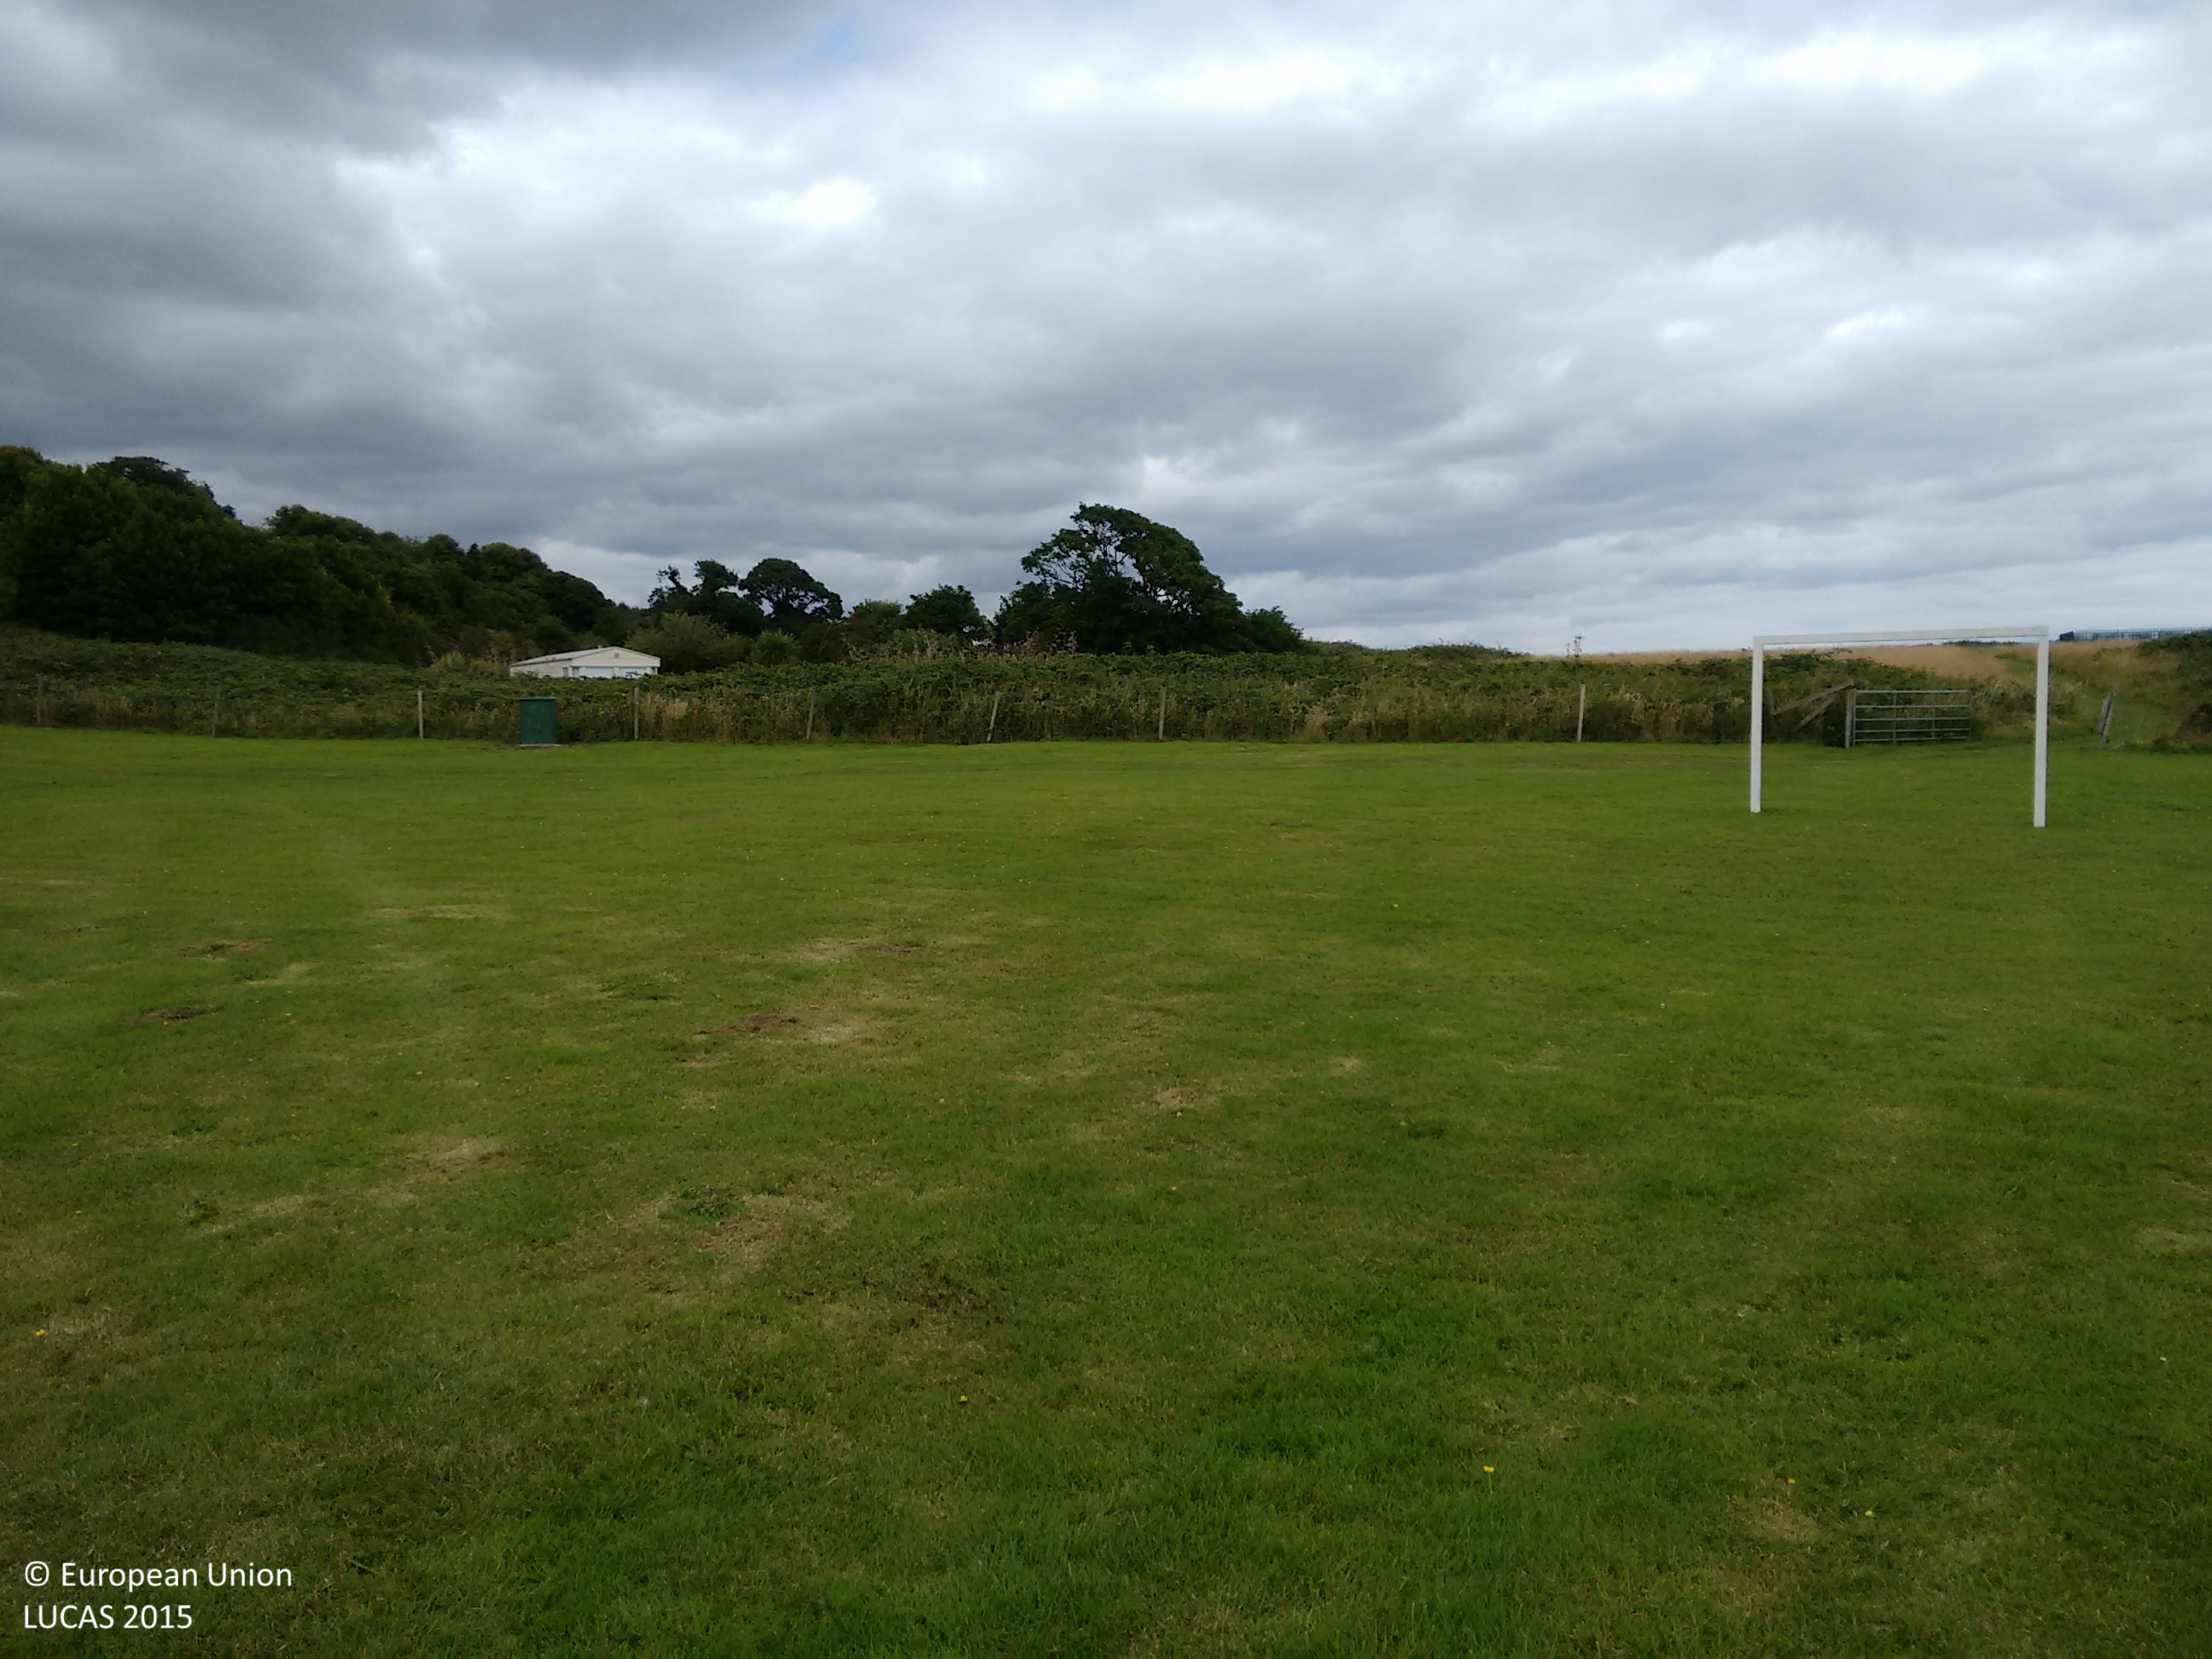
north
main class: Grassland
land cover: Grassland without tree/shrub cover
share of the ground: > 75 %
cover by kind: herbaceous plants 100 %
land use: Amenities, museums, leisure
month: July
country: IE
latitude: 52.9099
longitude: -6.0396
